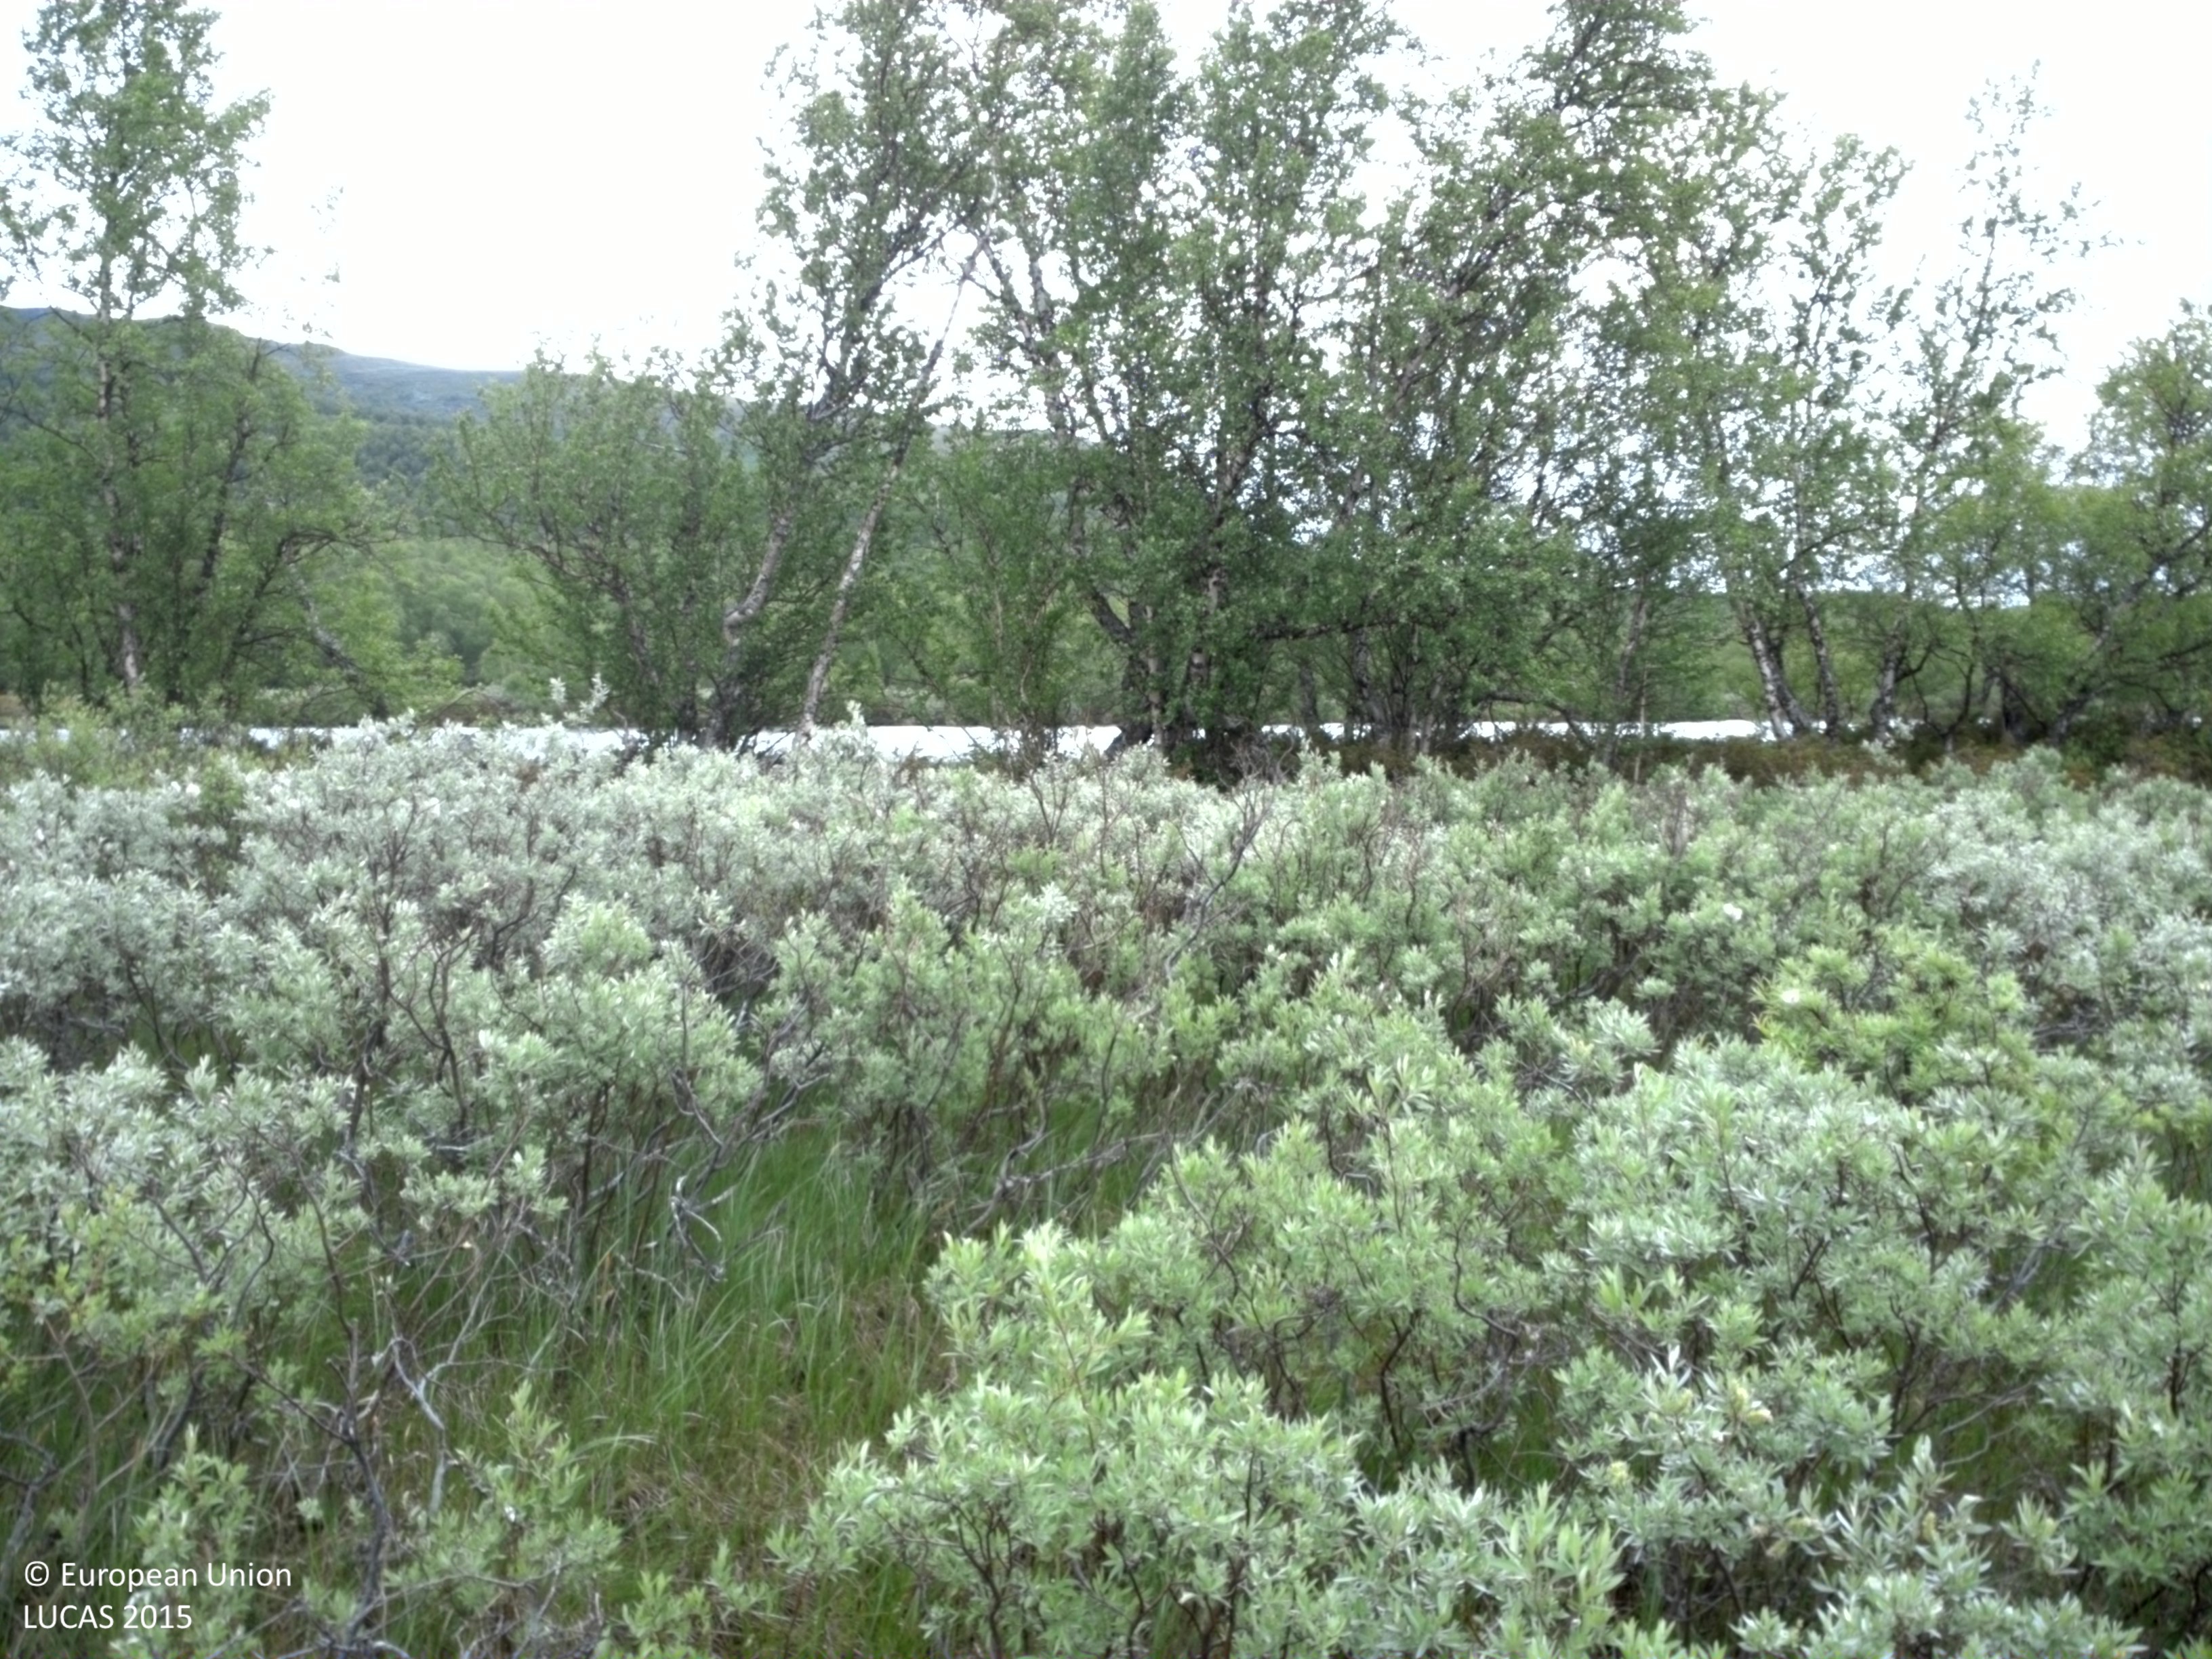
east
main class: Shrubland
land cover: Shrubland without tree cover
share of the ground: 50 - 75 %
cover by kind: shrubs 50 %, herbaceous plants 50 %
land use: Semi-natural and natural areas not in use
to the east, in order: Shrubland without tree cover; Broadleaved woodland; Inland fresh running water; Shrubland with sparse tree cover; Inland fresh water bodies; Peatbogs; Shrubland with sparse tree cover; Broadleaved woodland
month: July
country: SE
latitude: 65.7636
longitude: 15.1388
